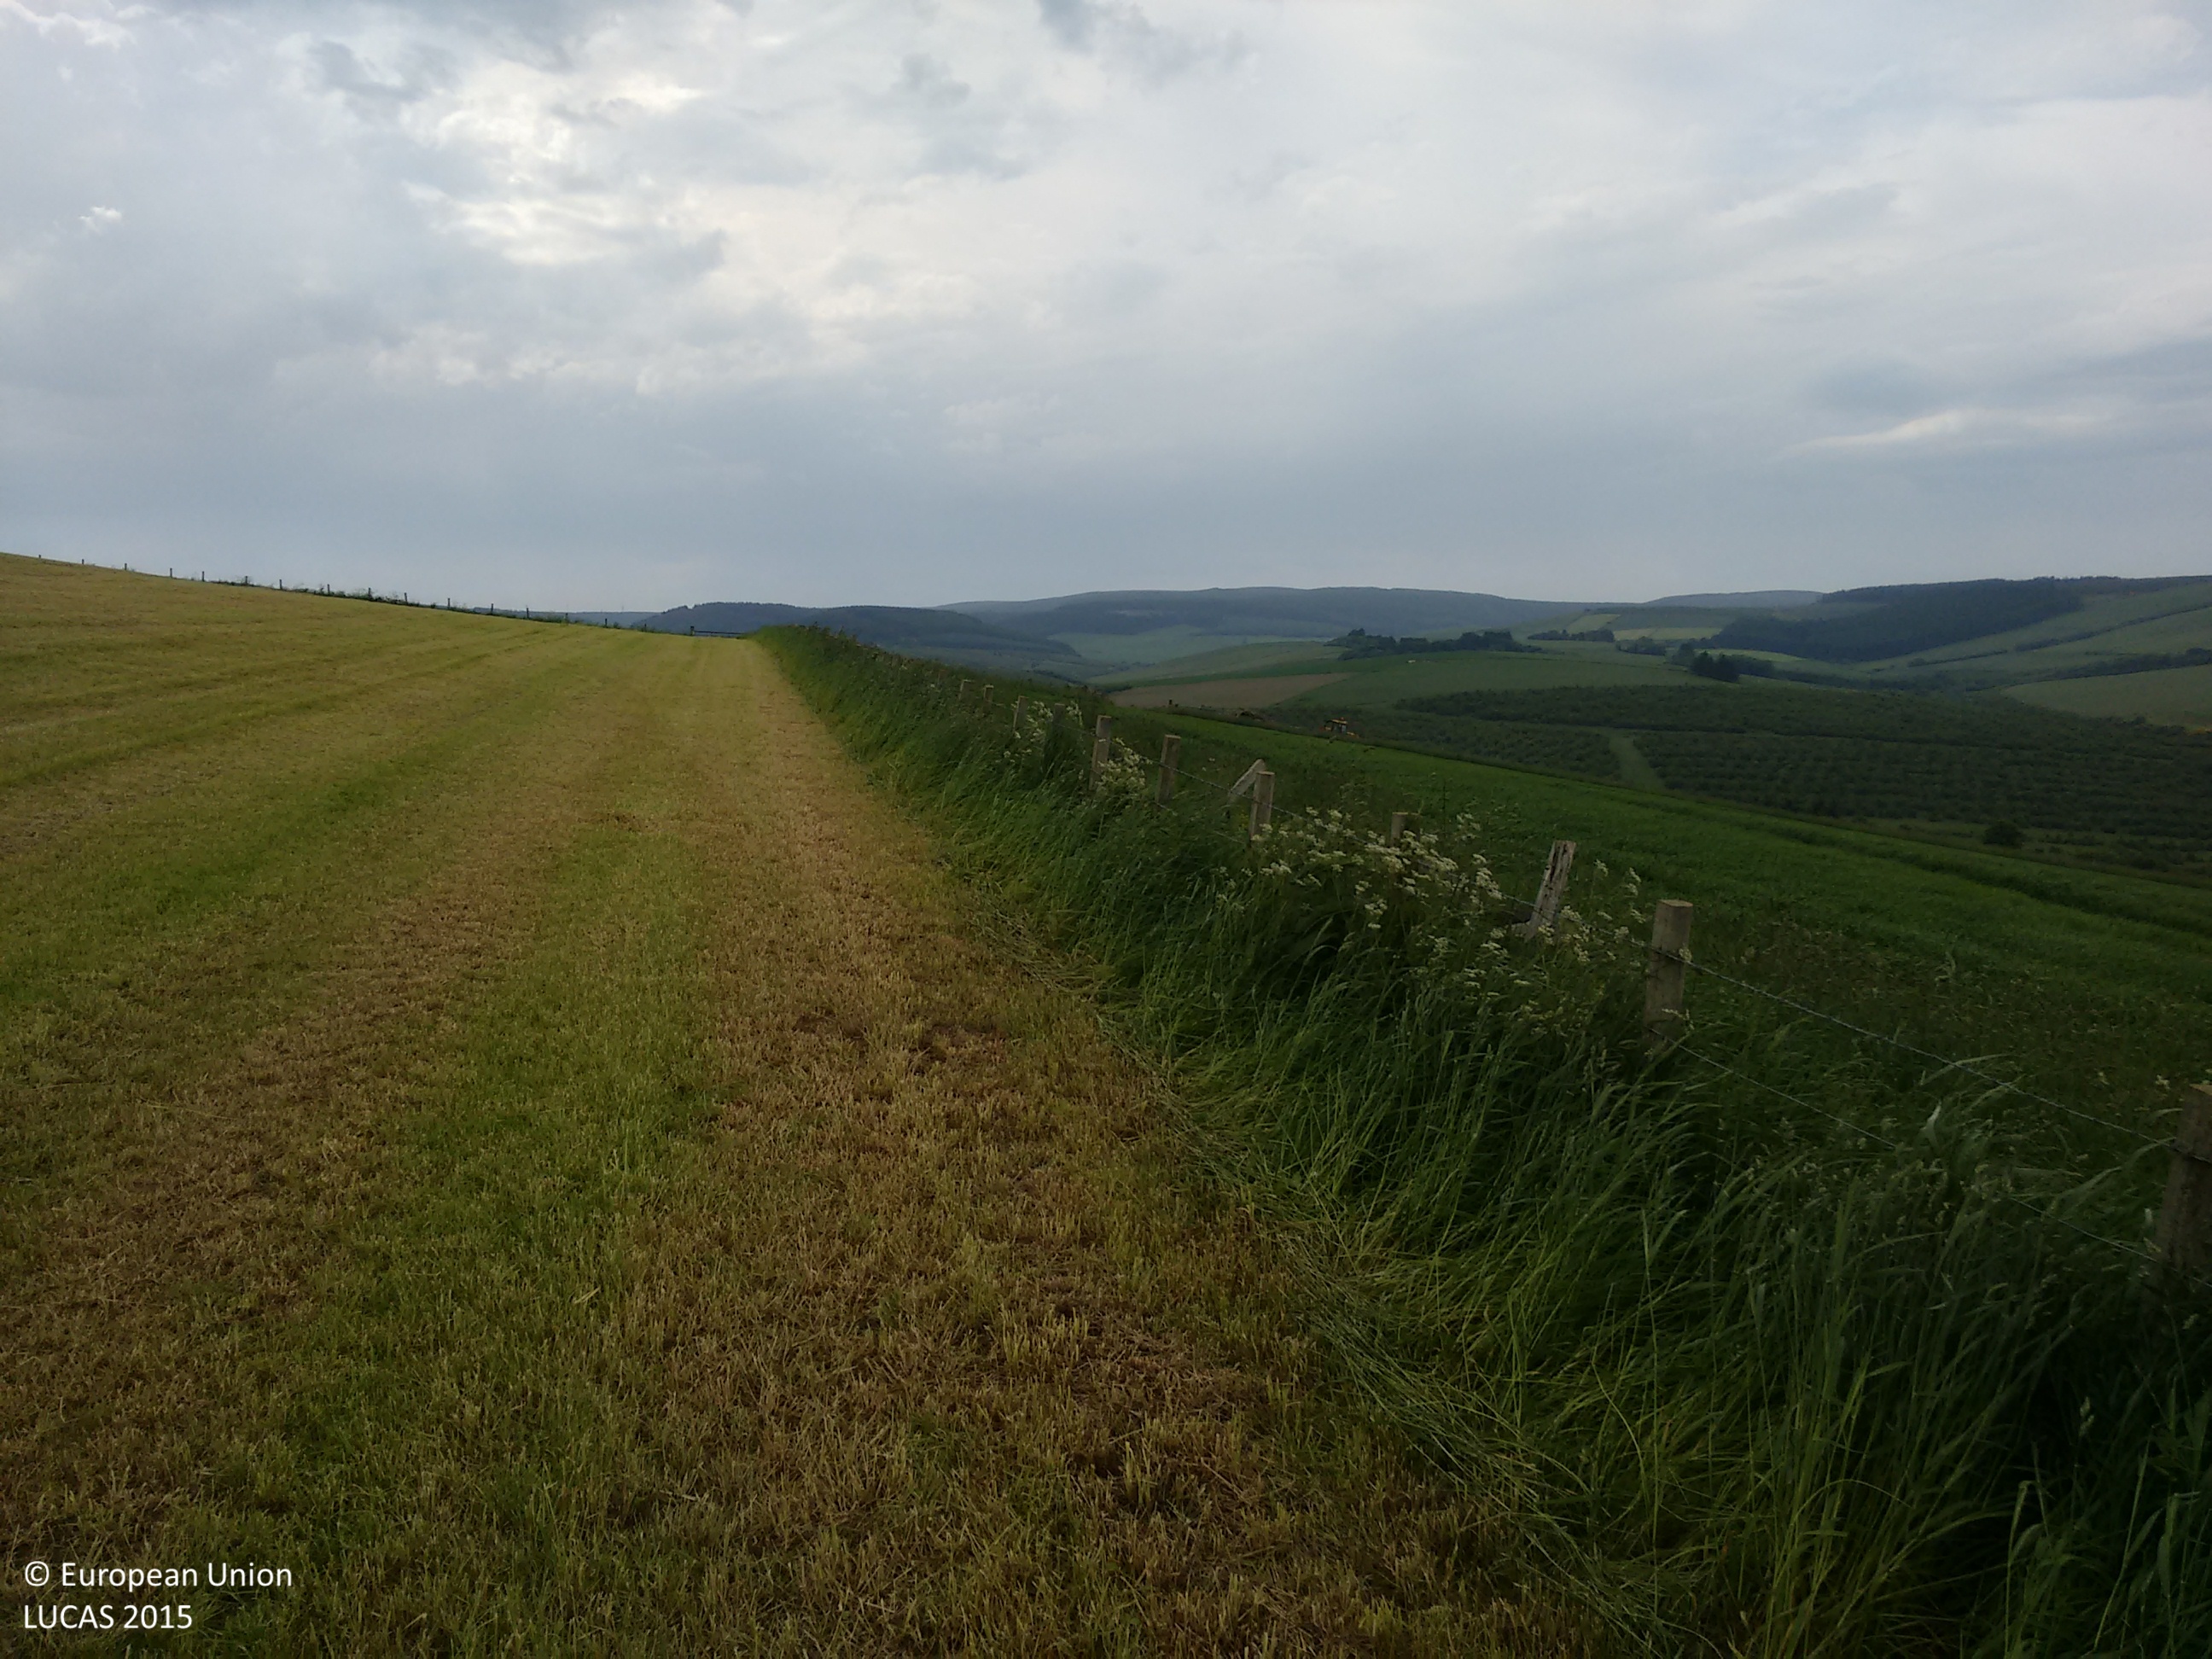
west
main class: Cropland
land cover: Temporary grasslands
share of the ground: 50 - 75 %
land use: Agriculture (excluding fallow land and kitchen gardens)
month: July
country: GB
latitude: 57.4012
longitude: -2.8232
